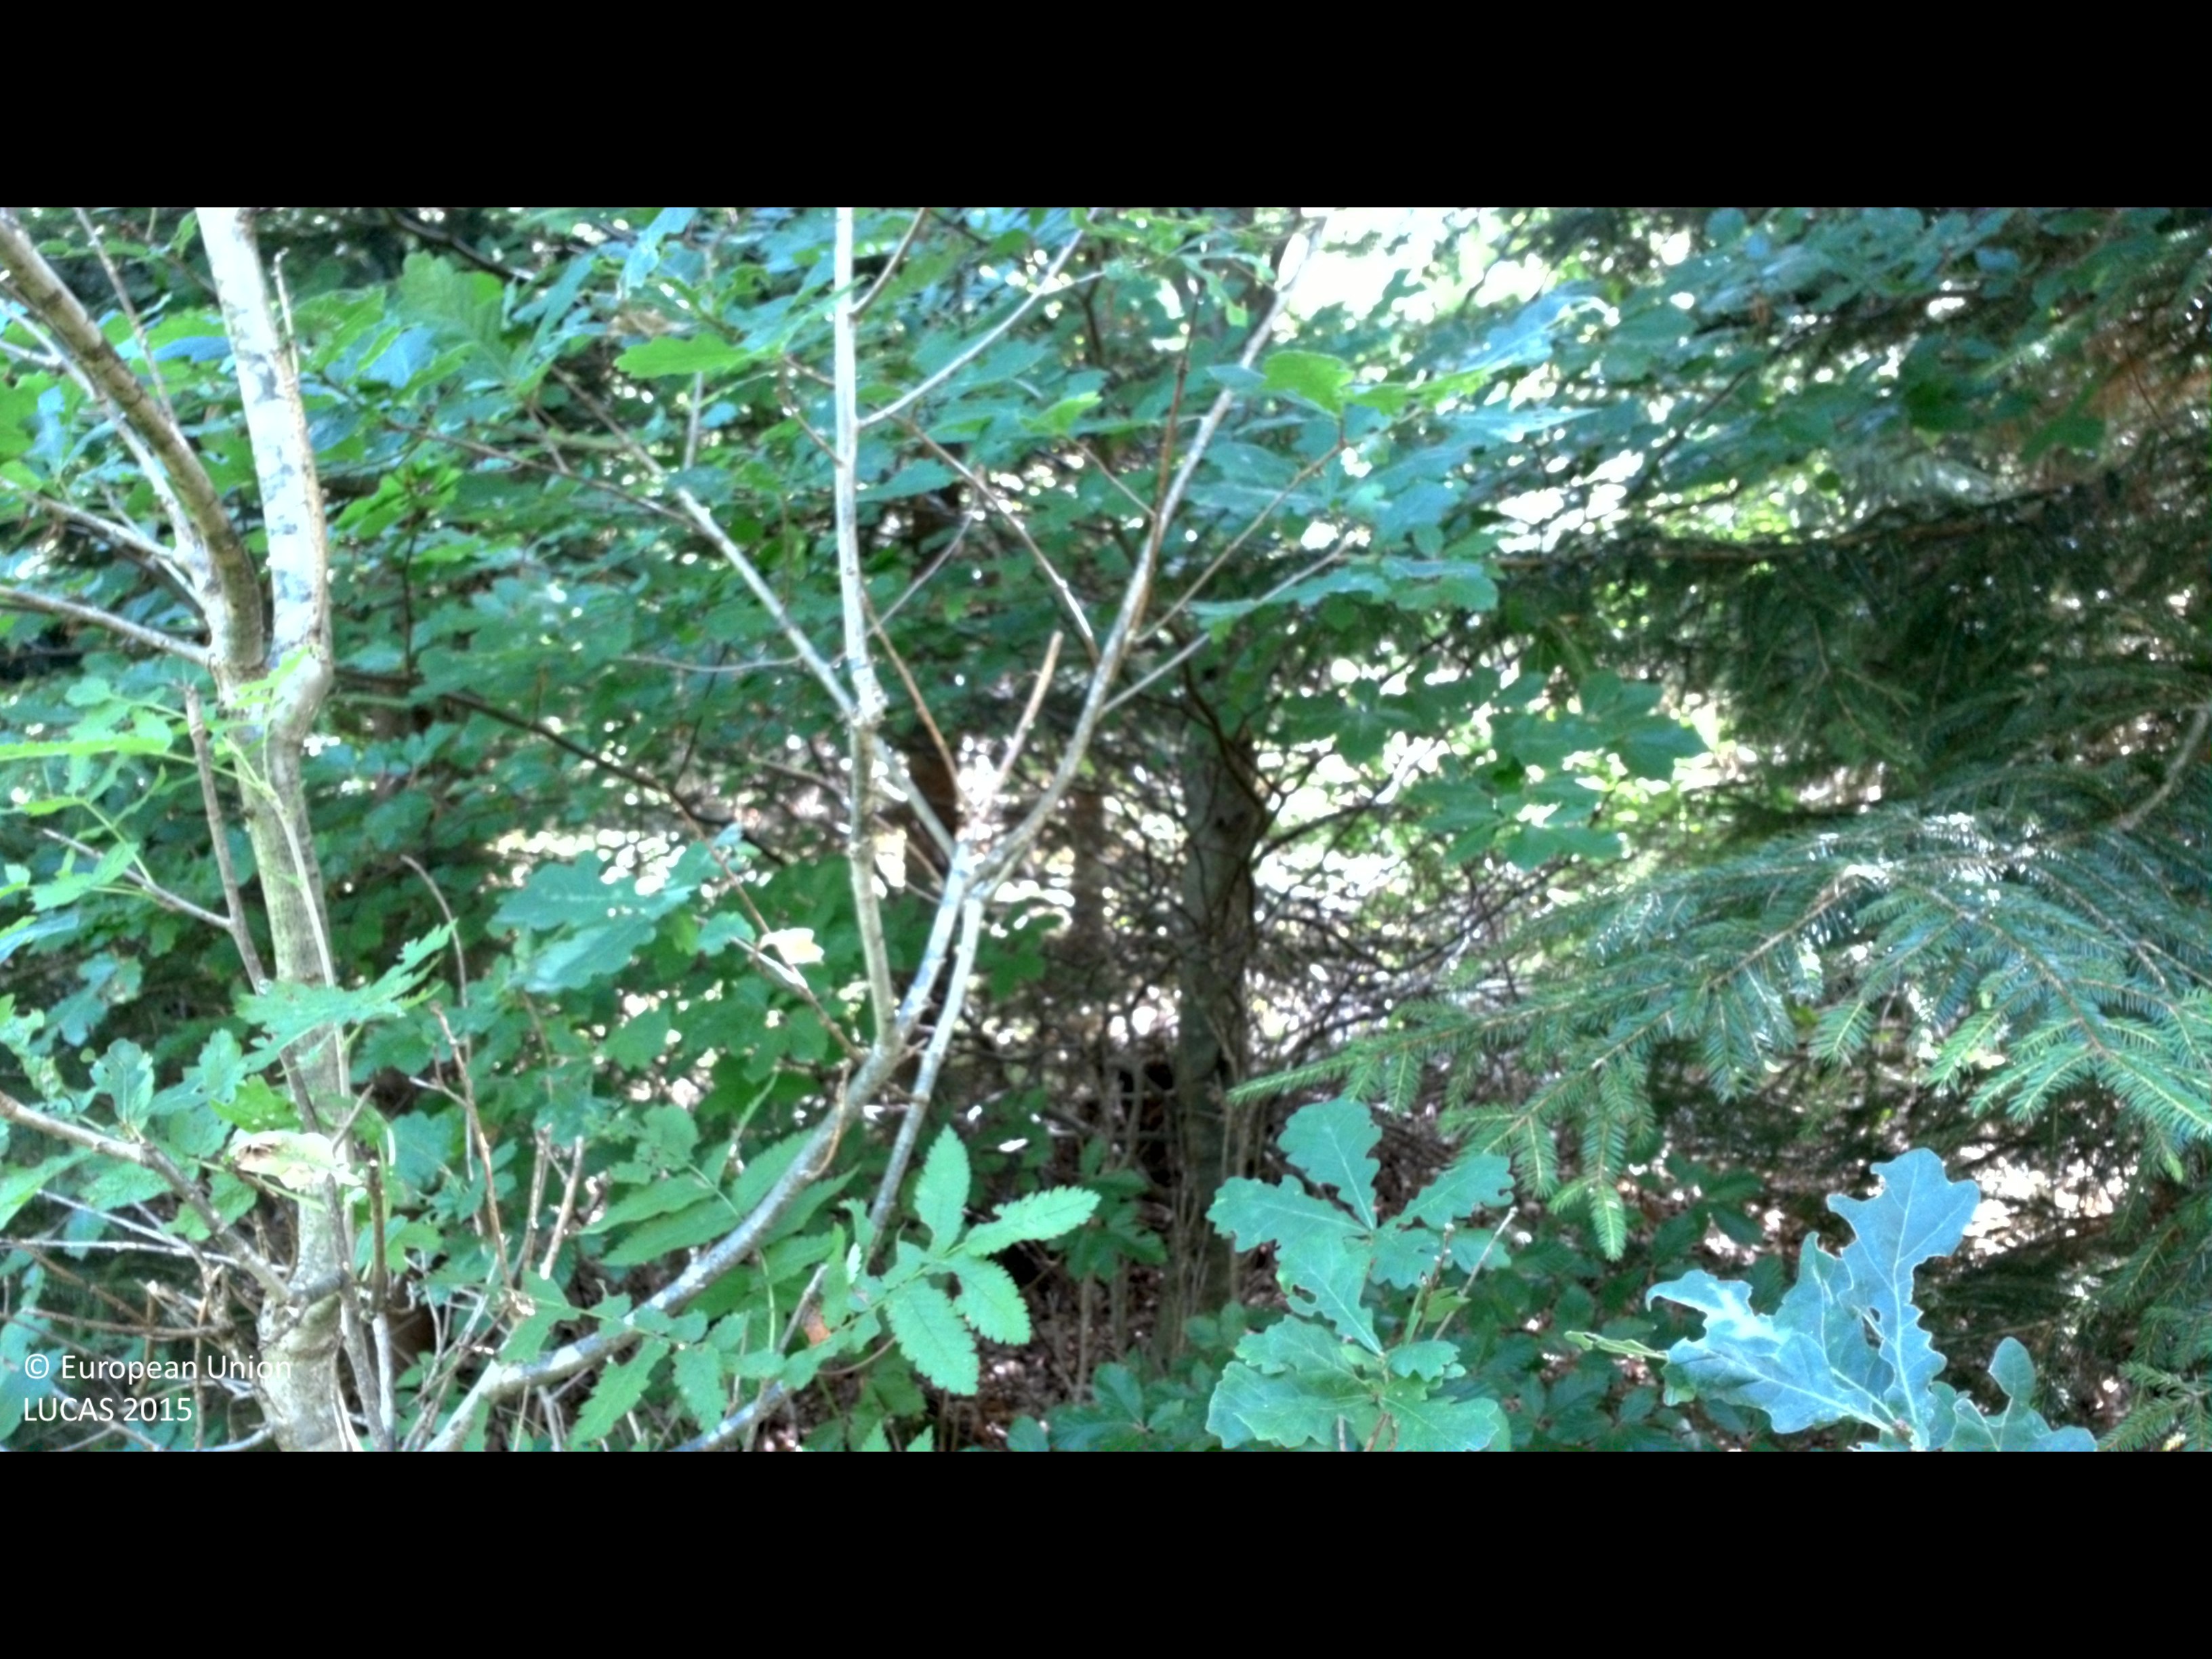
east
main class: Woodland
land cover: Spruce dominated mixed woodland
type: boreal forest
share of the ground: 50 - 75 %
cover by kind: coniferous forest trees 40 %, herbaceous plants 30 %, broadleaved forest trees 25 %, shrubs 5 %
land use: Forestry
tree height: > 5 m
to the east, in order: Spruce dominated mixed woodland; Tracks; Broadleaved woodland; Spruce dominated coniferous woodland; Broadleaved woodland; Spruce dominated coniferous woodland
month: August
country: SE
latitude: 56.2867
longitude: 15.8969
